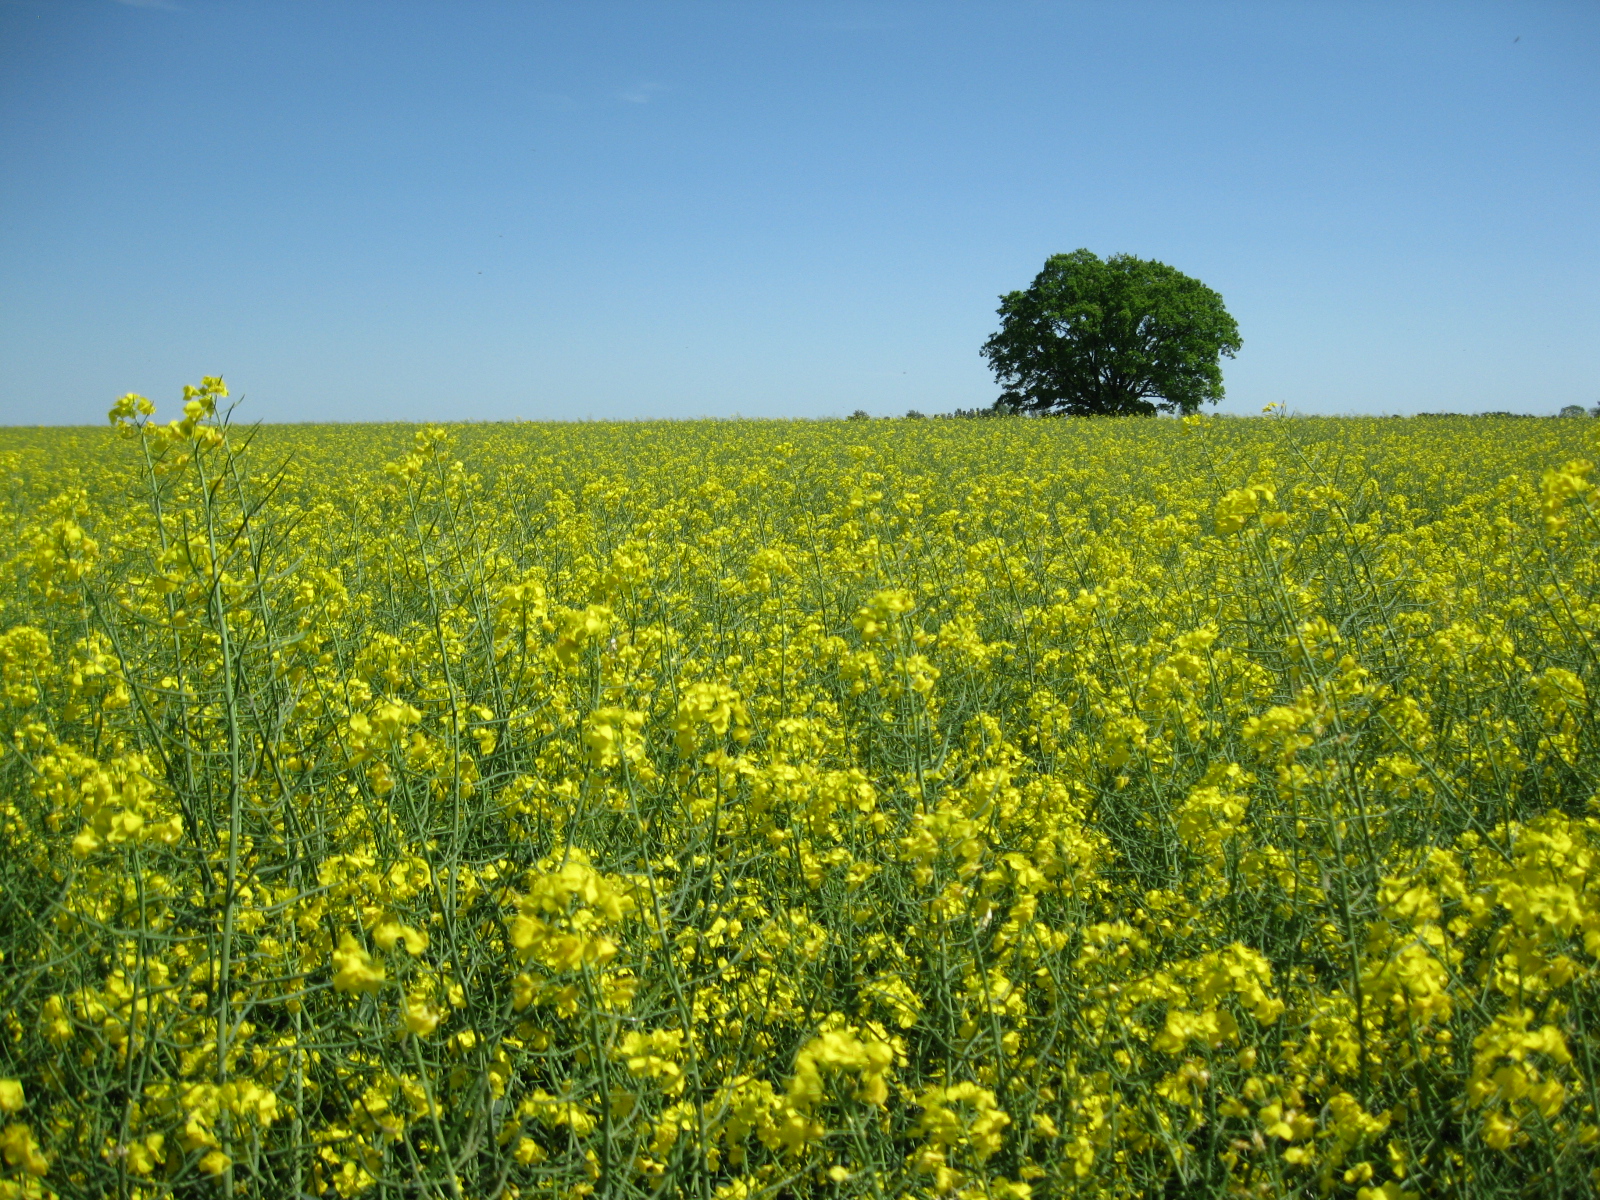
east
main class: Cropland
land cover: Rape and turnip rape
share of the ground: > 75 %
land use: Agriculture (excluding fallow land and kitchen gardens)
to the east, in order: Rape and turnip rape
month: June
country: LT
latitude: 55.9550
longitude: 23.7439
